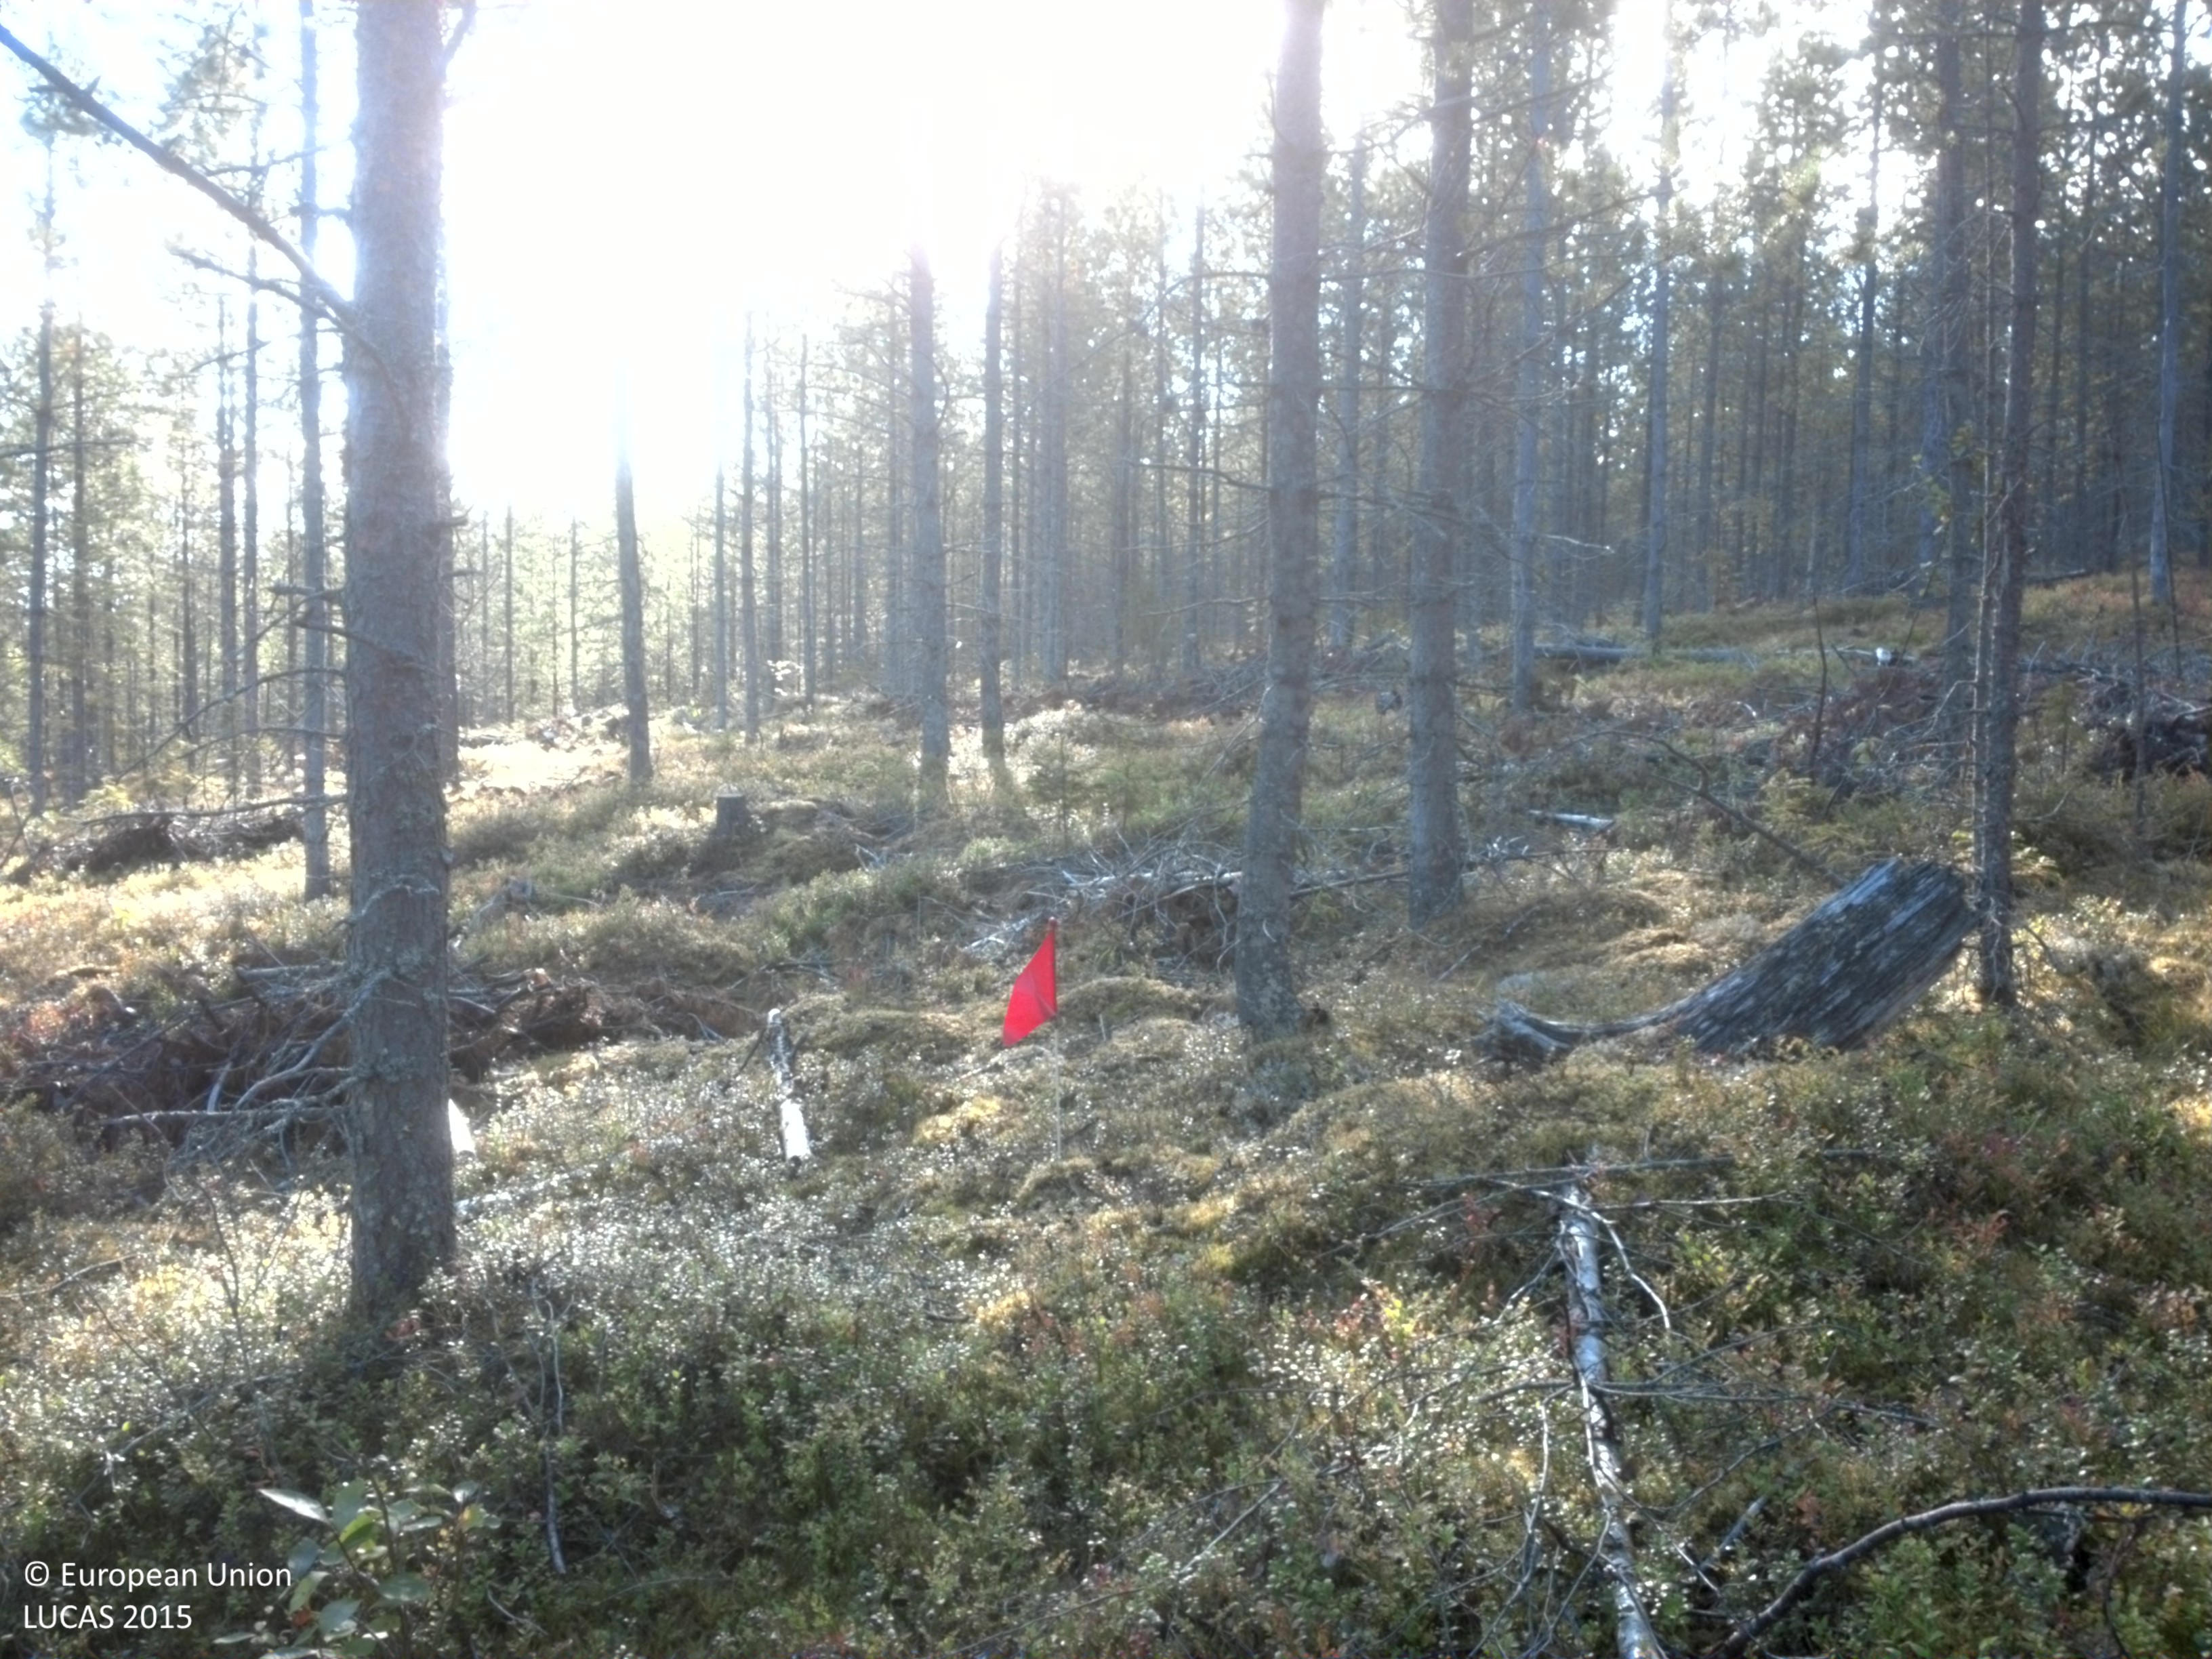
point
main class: Woodland
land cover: Pine dominated coniferous woodland
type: exotic forest
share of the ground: 50 - 75 %
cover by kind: coniferous forest trees 70 %, shrubs 20 %, lichens and mosses 10 %
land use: Forestry
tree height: > 5 m
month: September
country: SE
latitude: 64.5560
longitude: 19.0858
